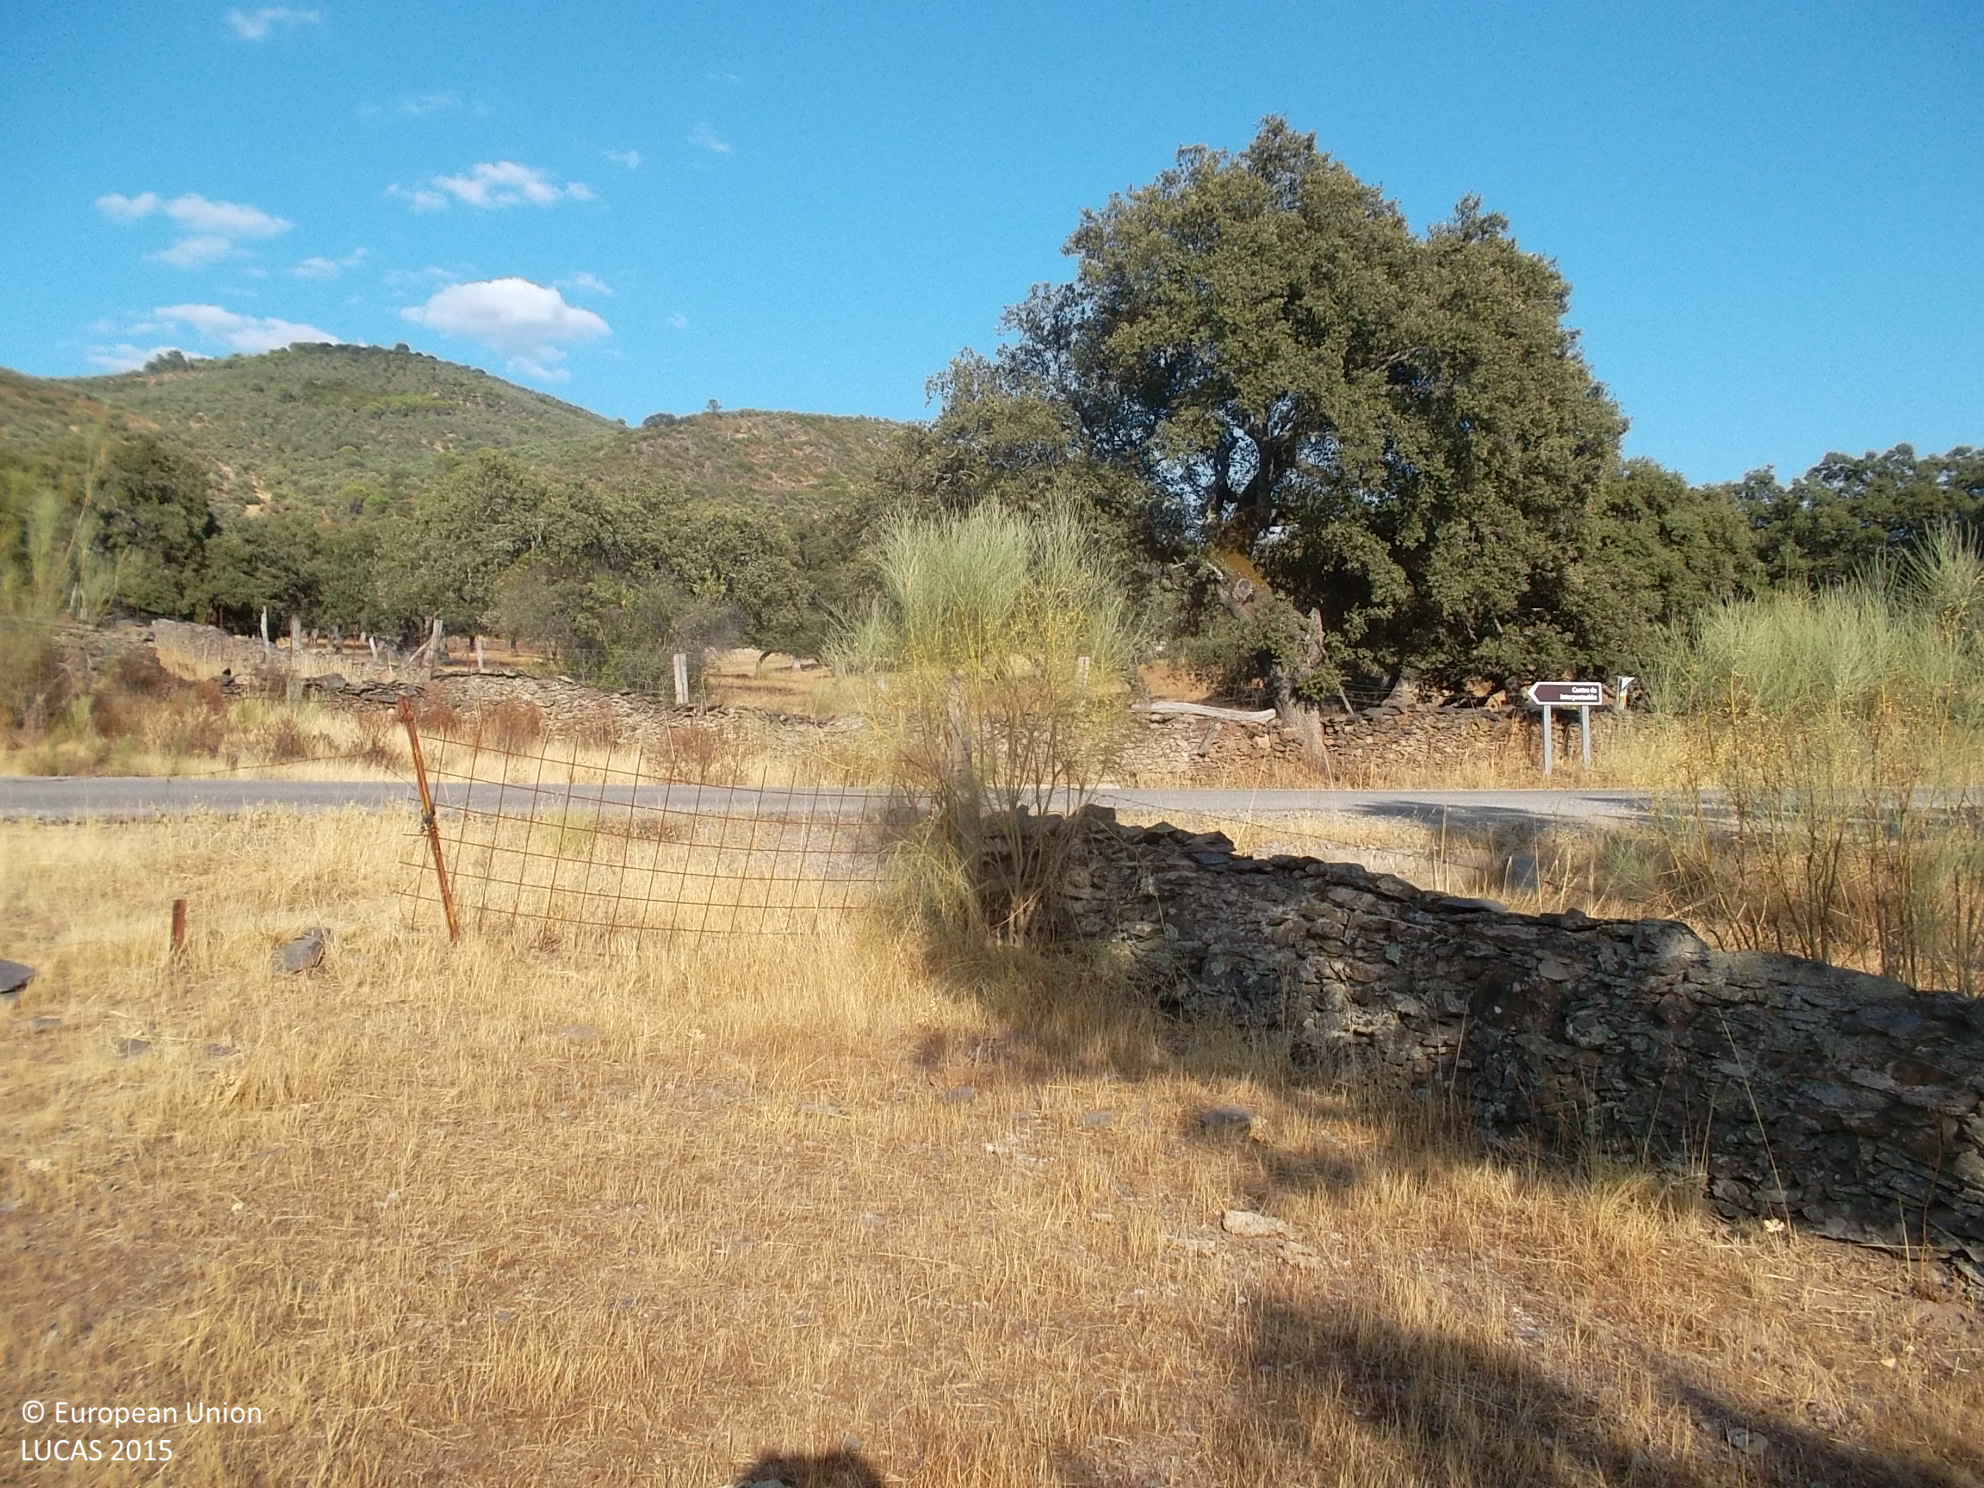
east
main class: Woodland
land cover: Broadleaved woodland
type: broadleaved evergreen forest
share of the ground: 25 - 50 %
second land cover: Grassland without tree/shrub cover
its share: > 75 %
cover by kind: herbaceous plants 75 %, broadleaved forest trees 25 %
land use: Forestry
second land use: Agriculture (excluding fallow land and kitchen gardens)
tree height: > 5 m
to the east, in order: Broadleaved woodland; Grassland without tree/shrub cover; Fences; Grass margins; Paved roads, cycling and walking lanes; Grass margins; Dry stone walls; Broadleaved woodland; Grassland without tree/shrub cover; Grassland with sparse tree/shrub cover
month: September
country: ES
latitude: 38.0149
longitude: -6.4802
